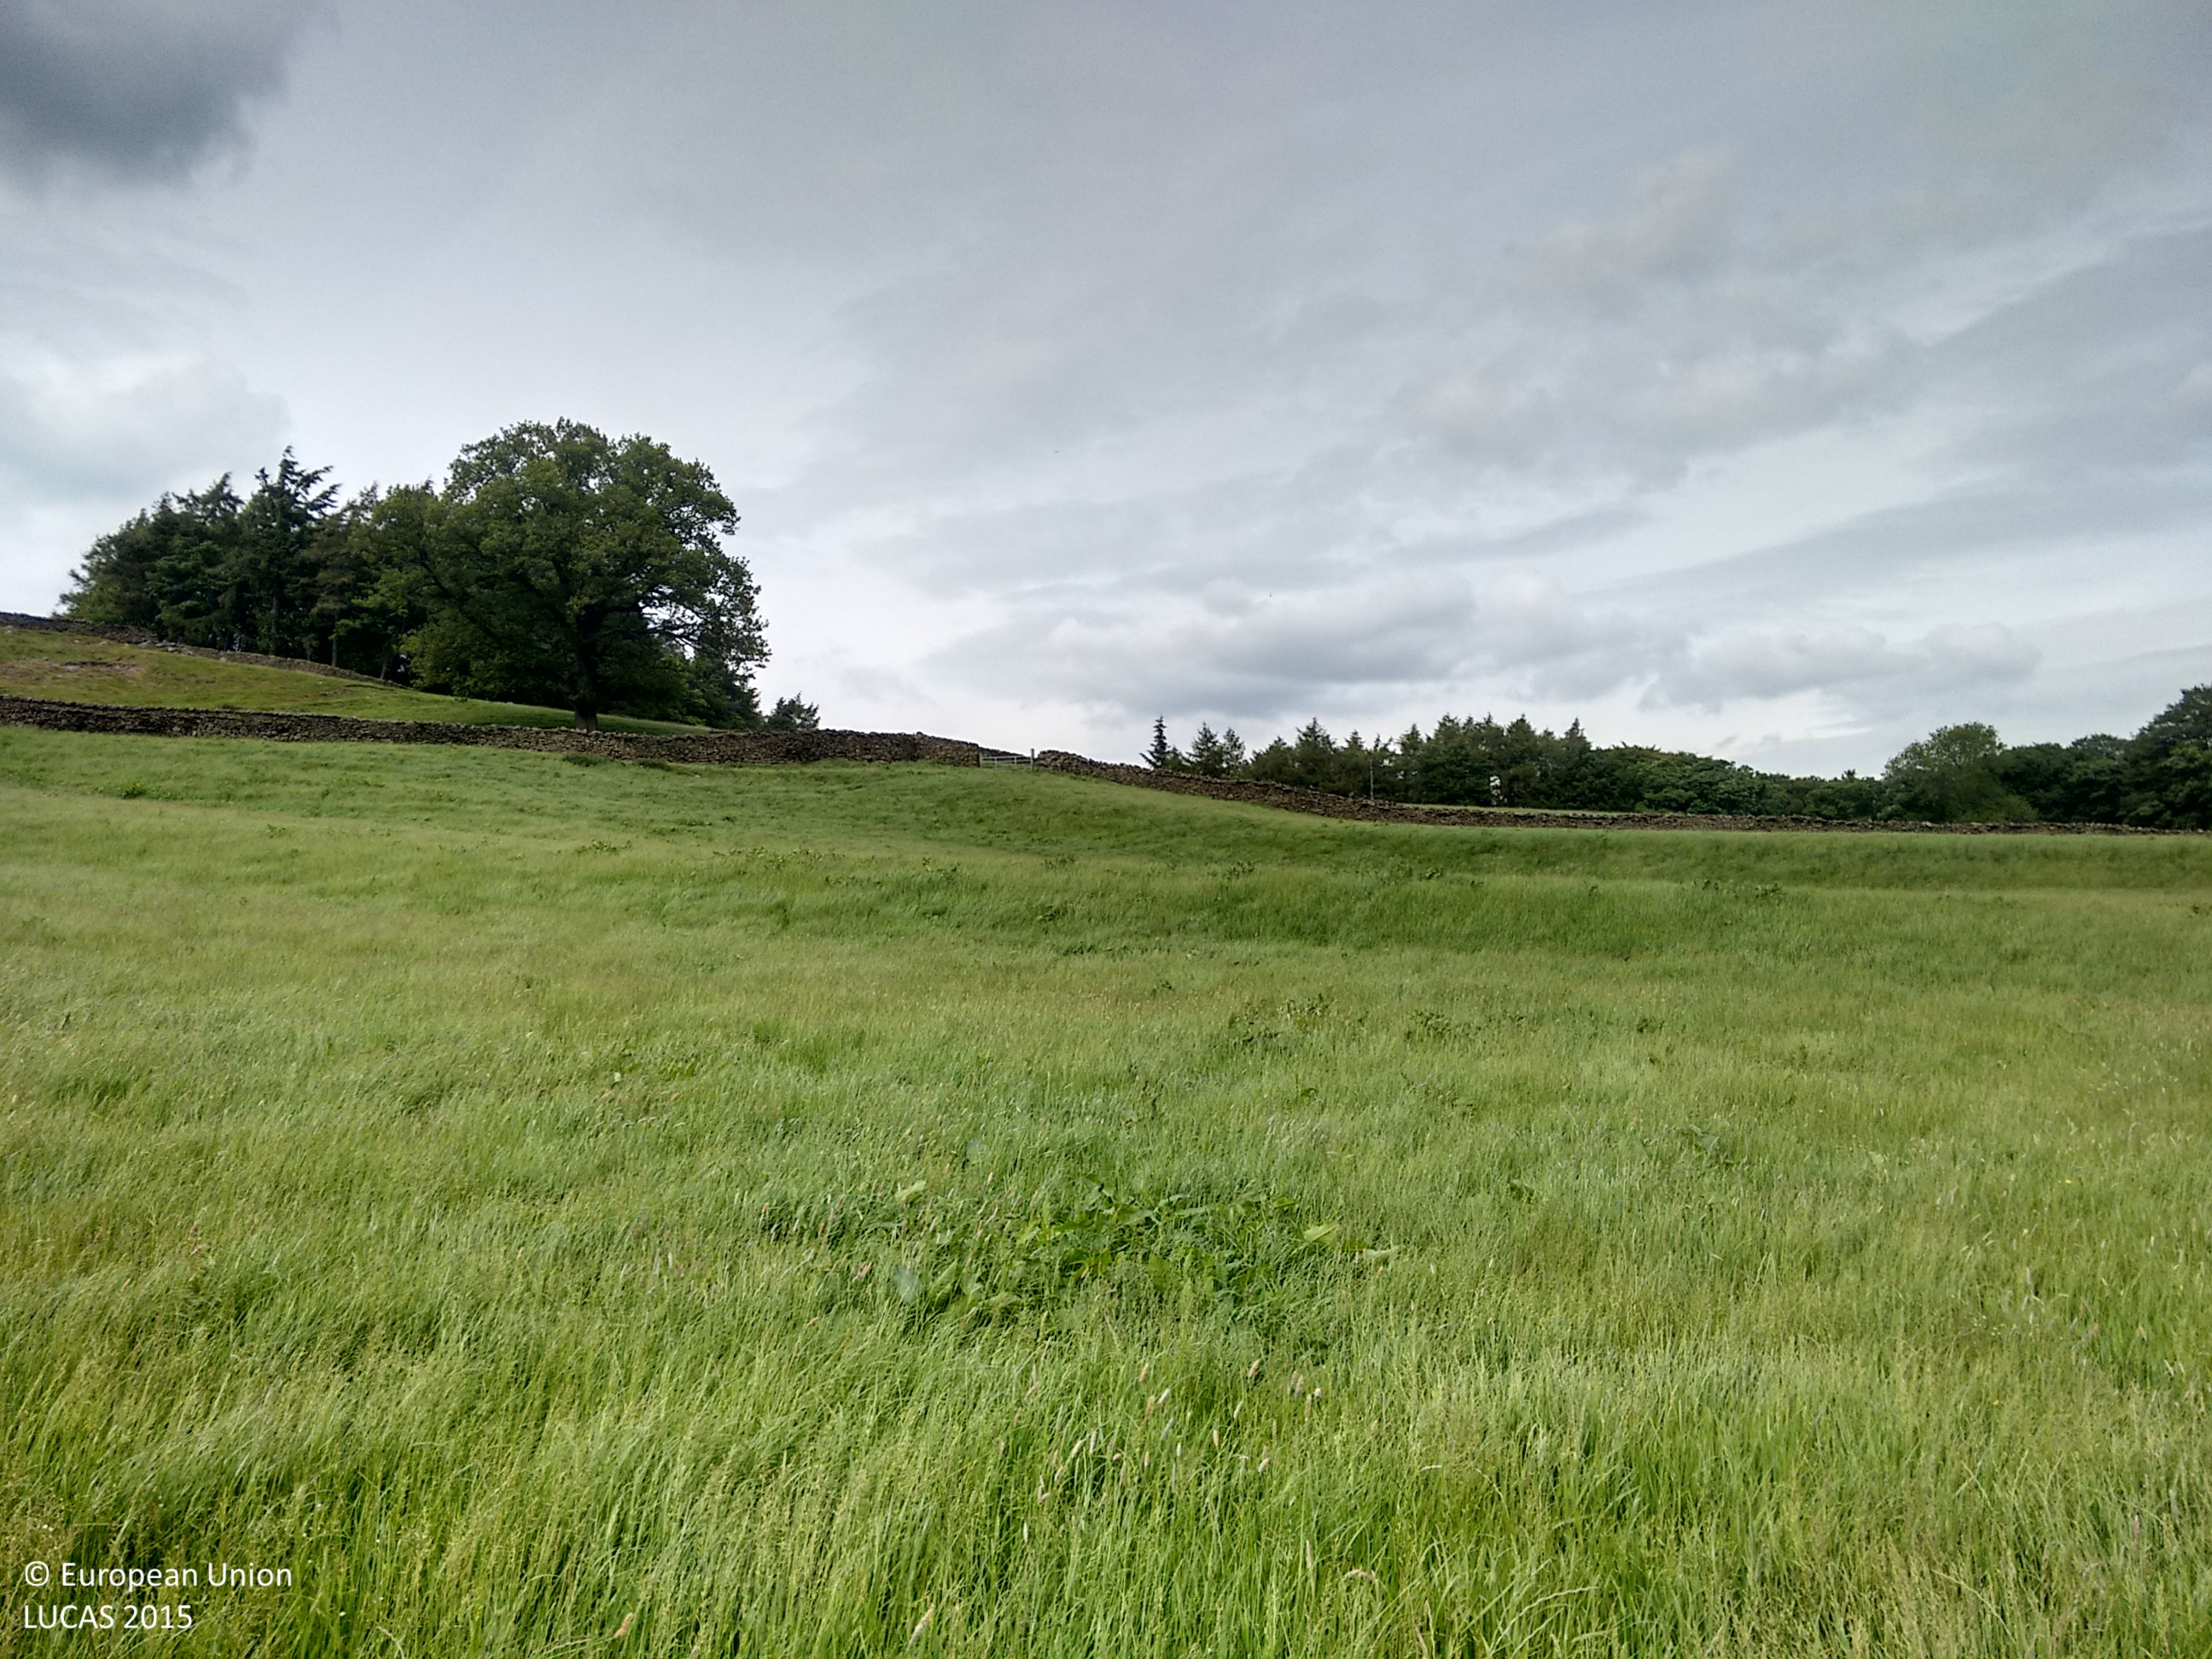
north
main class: Grassland
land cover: Grassland without tree/shrub cover
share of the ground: > 75 %
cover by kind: herbaceous plants 100 %
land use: Agriculture (excluding fallow land and kitchen gardens)
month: June
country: GB
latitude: 54.0292
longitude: -1.9174
